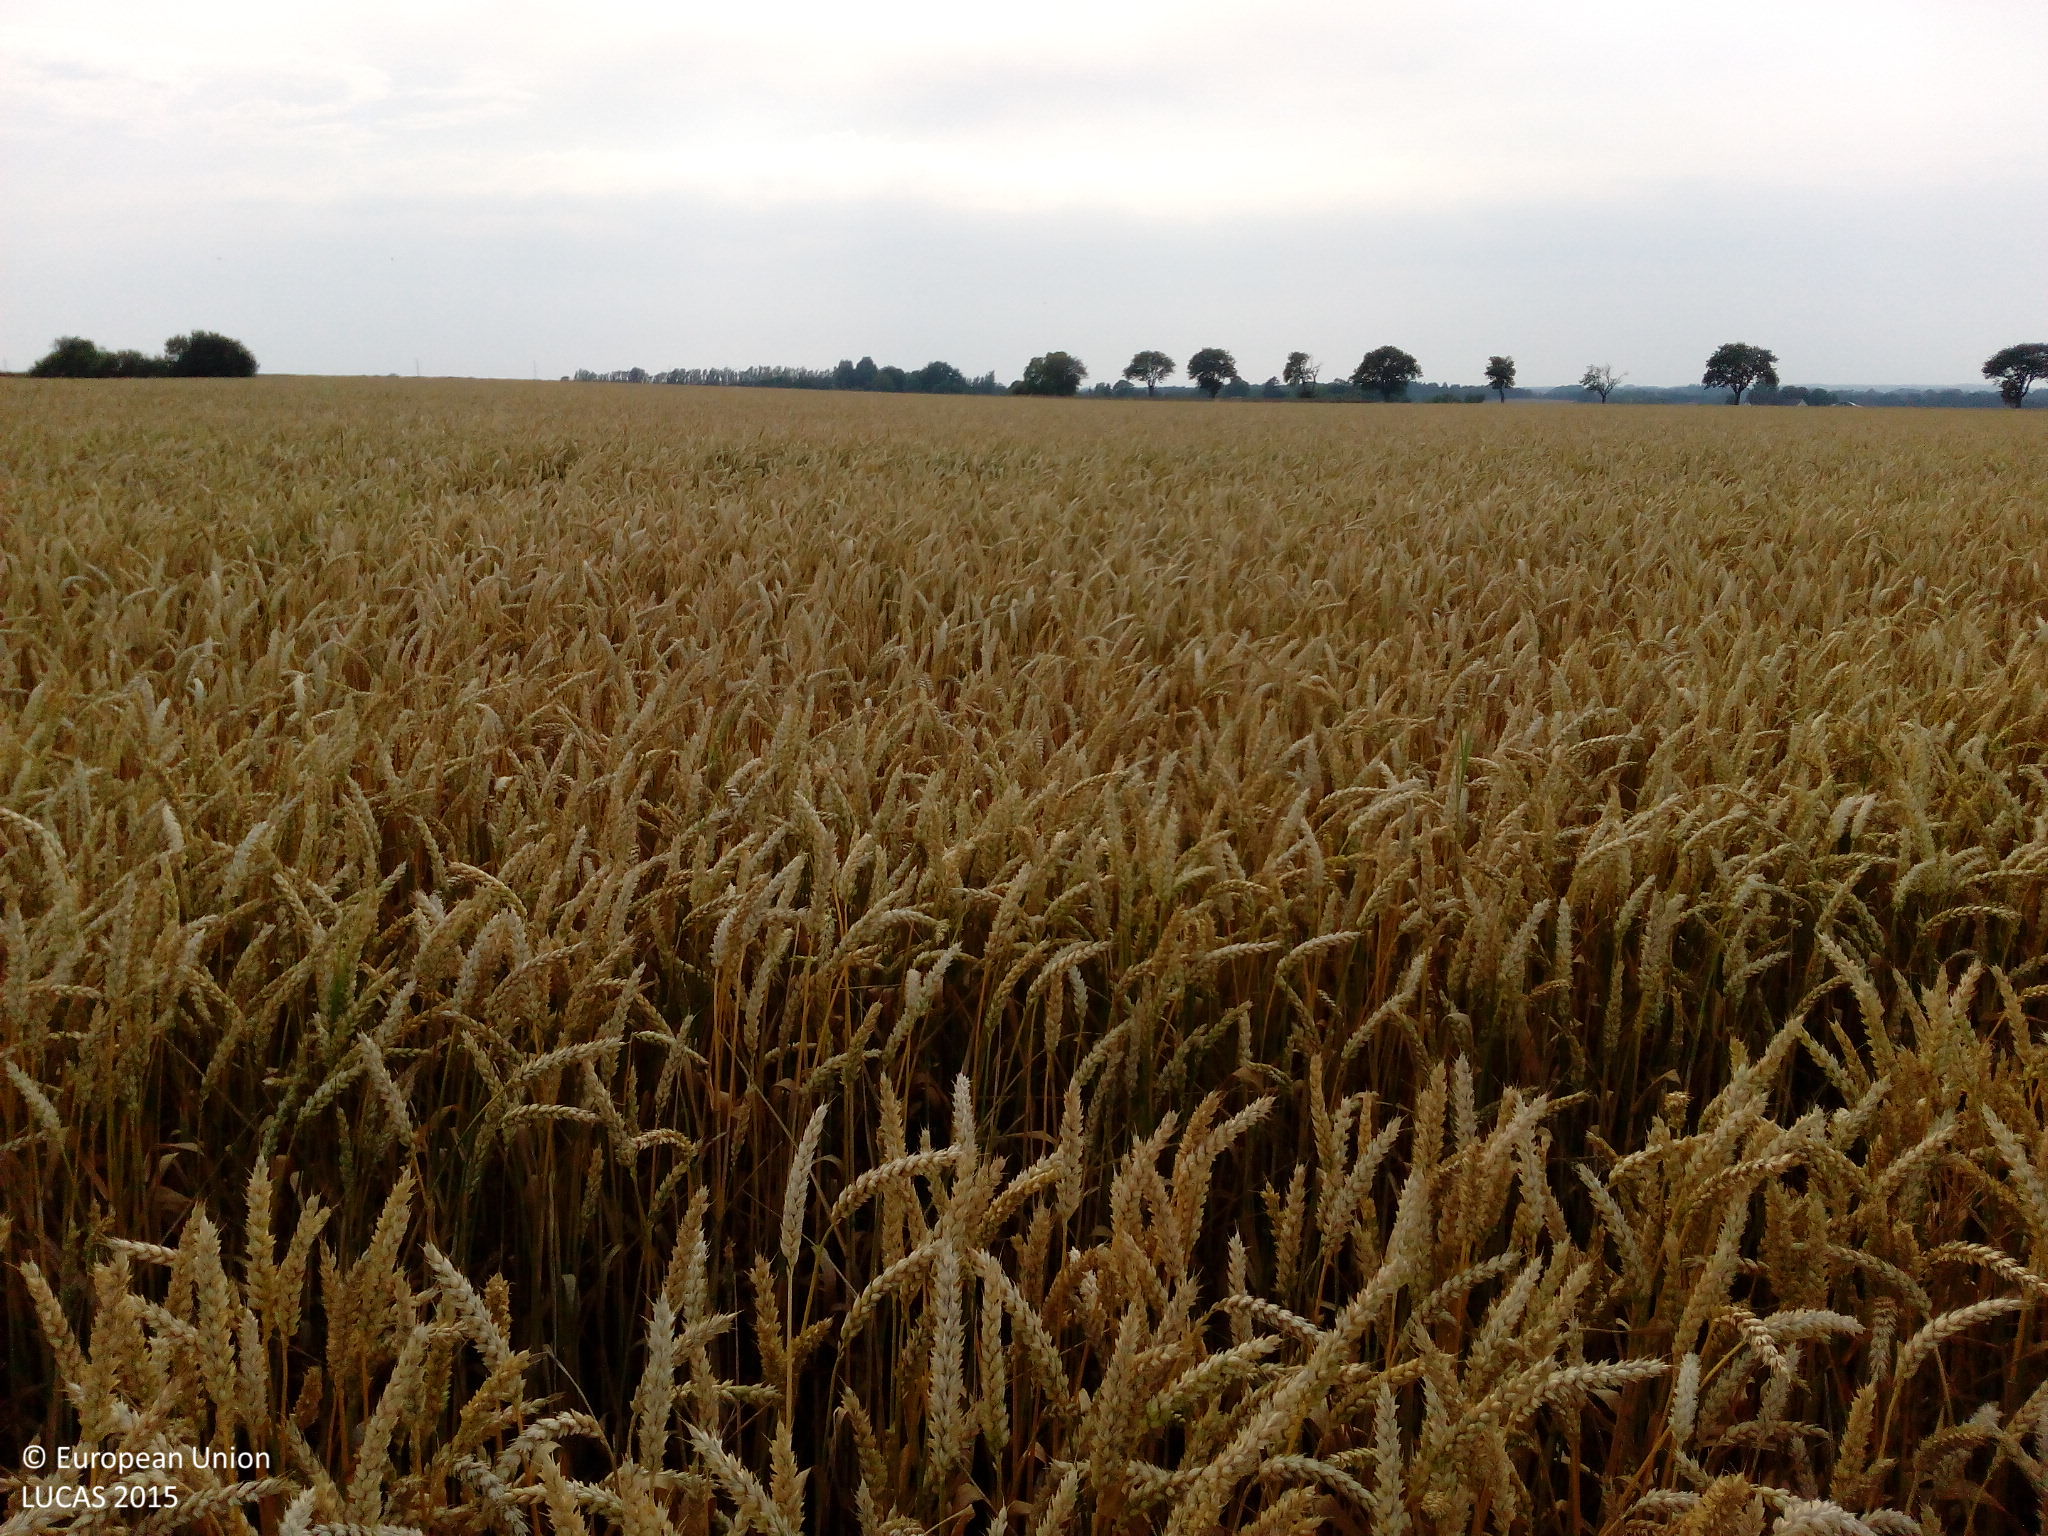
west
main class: Cropland
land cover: Common wheat
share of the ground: > 75 %
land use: Agriculture (excluding fallow land and kitchen gardens)
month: August
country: DK
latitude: 55.4741
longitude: 11.7862
